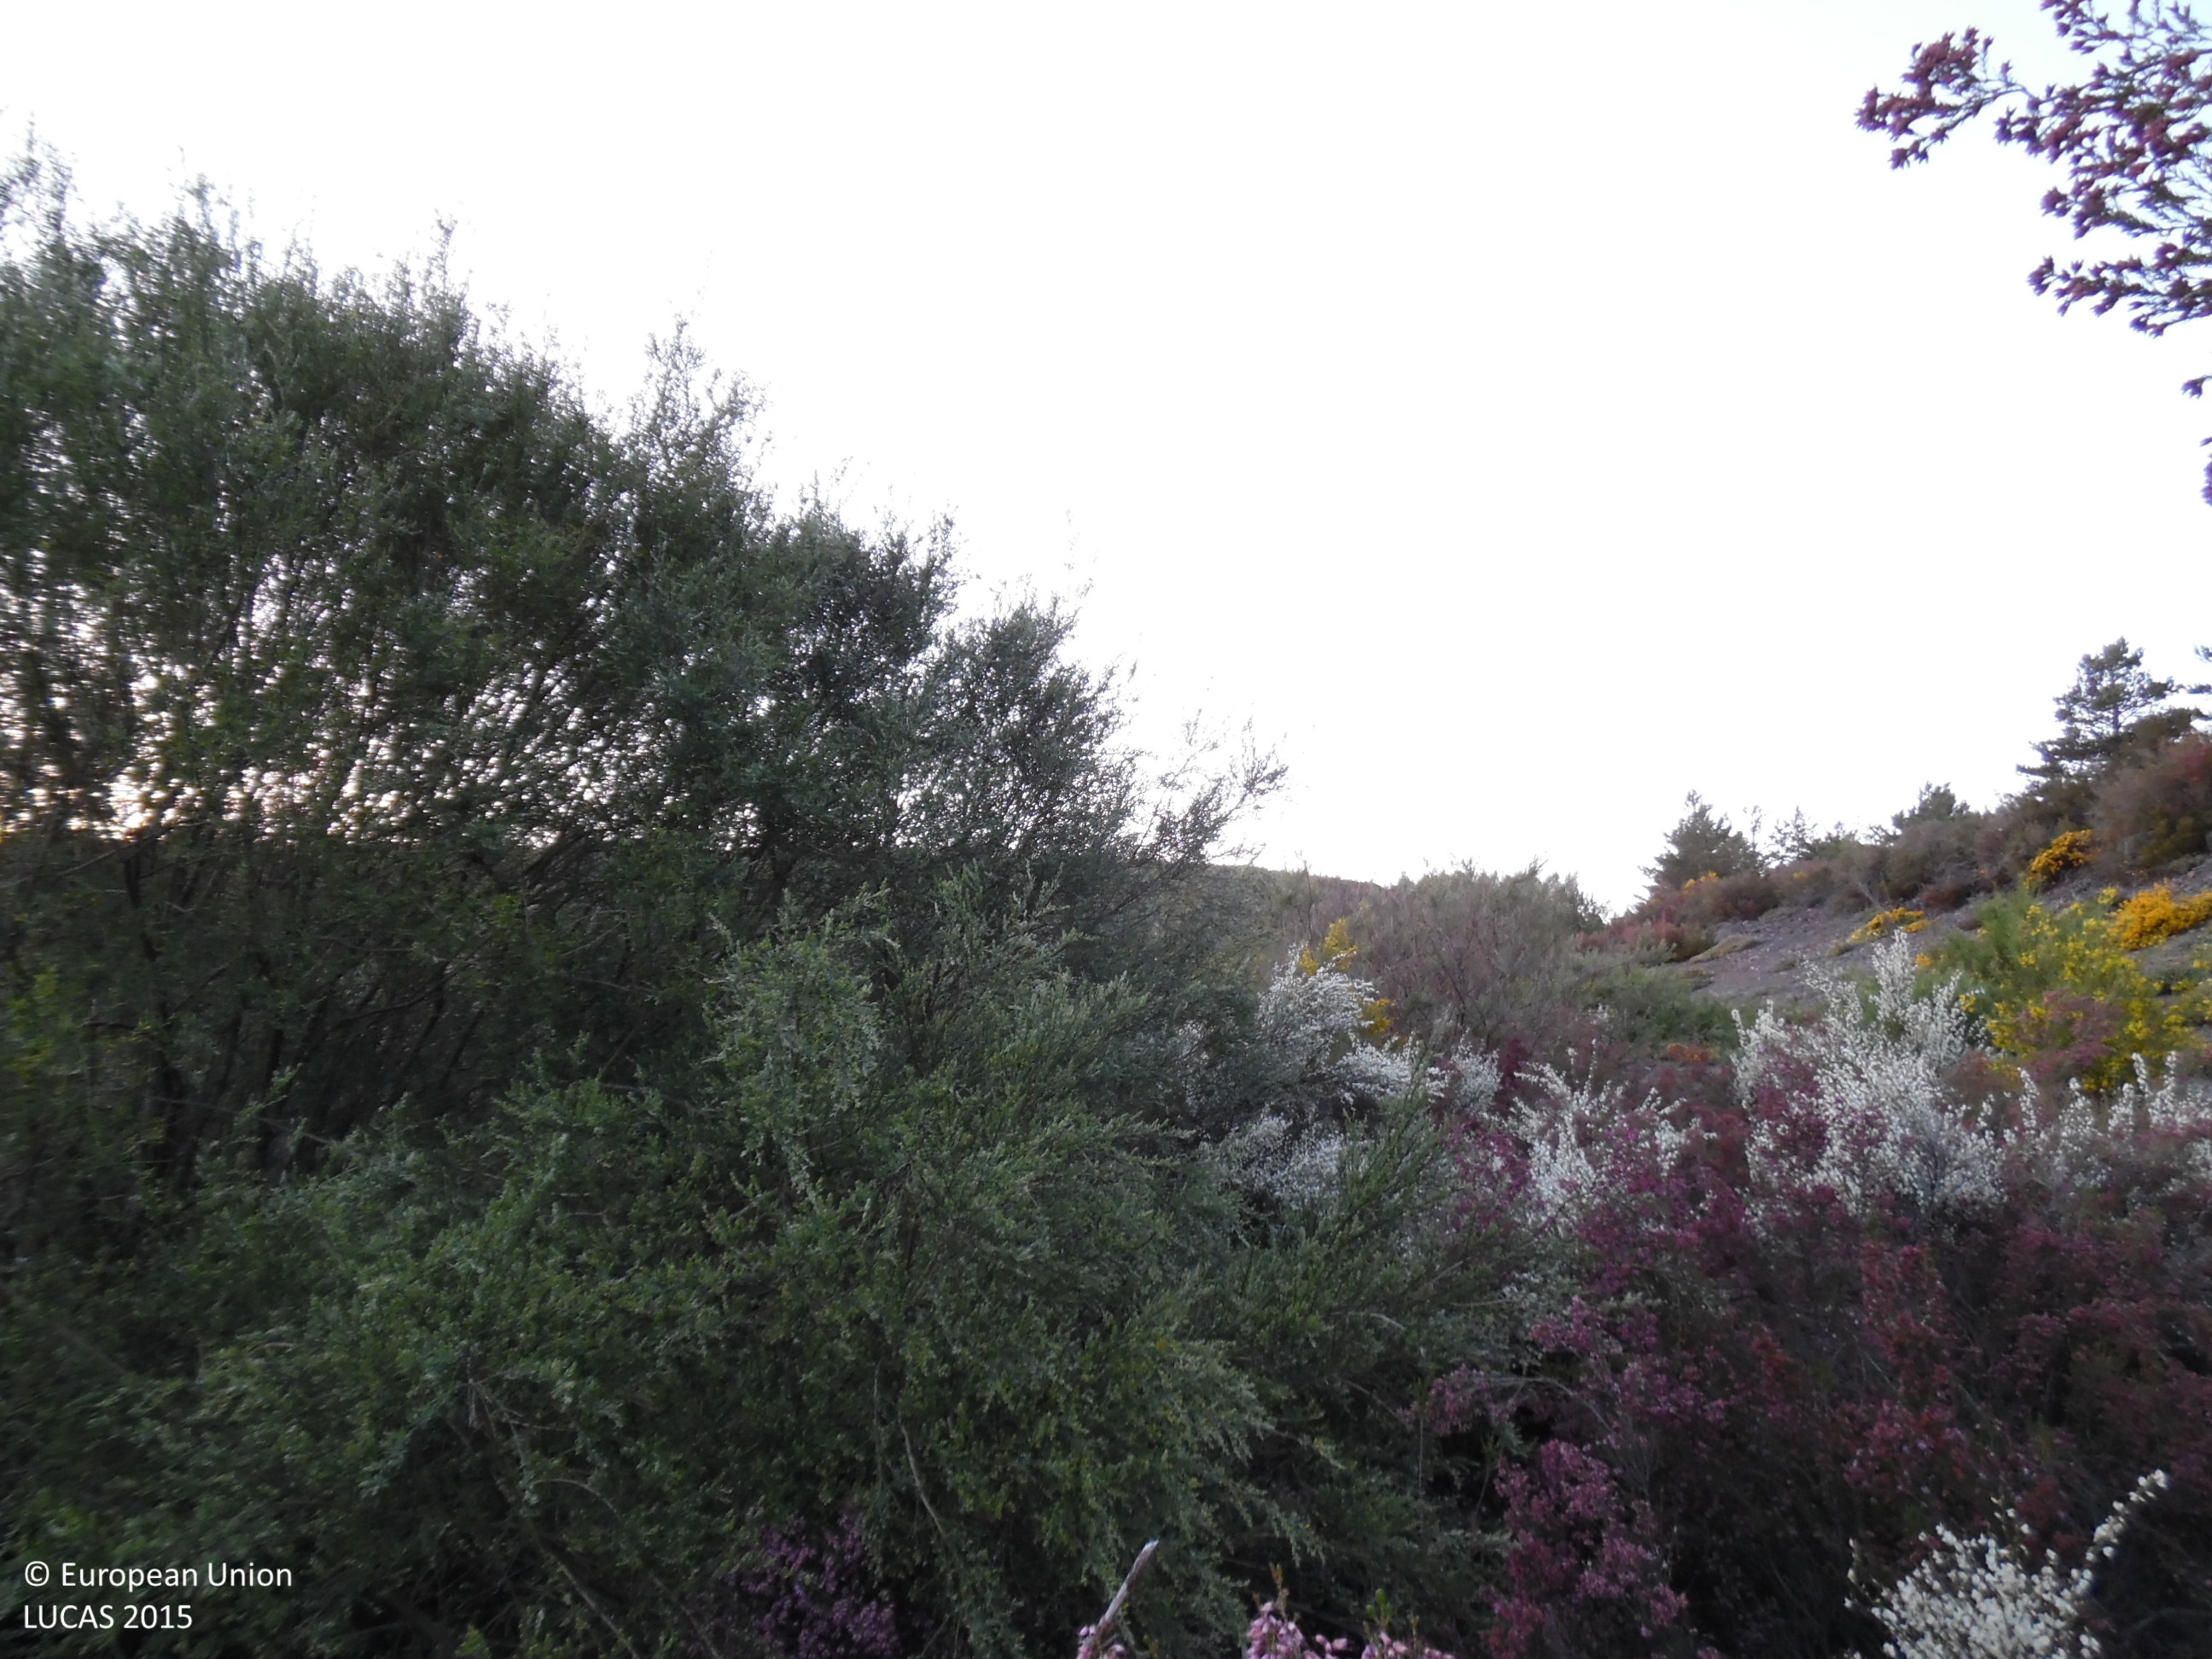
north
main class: Shrubland
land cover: Shrubland without tree cover
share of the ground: 50 - 75 %
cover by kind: shrubs 75 %, consolidated bare surface 25 %
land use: Semi-natural and natural areas not in use
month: May
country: ES
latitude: 42.6565
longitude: -6.1273
